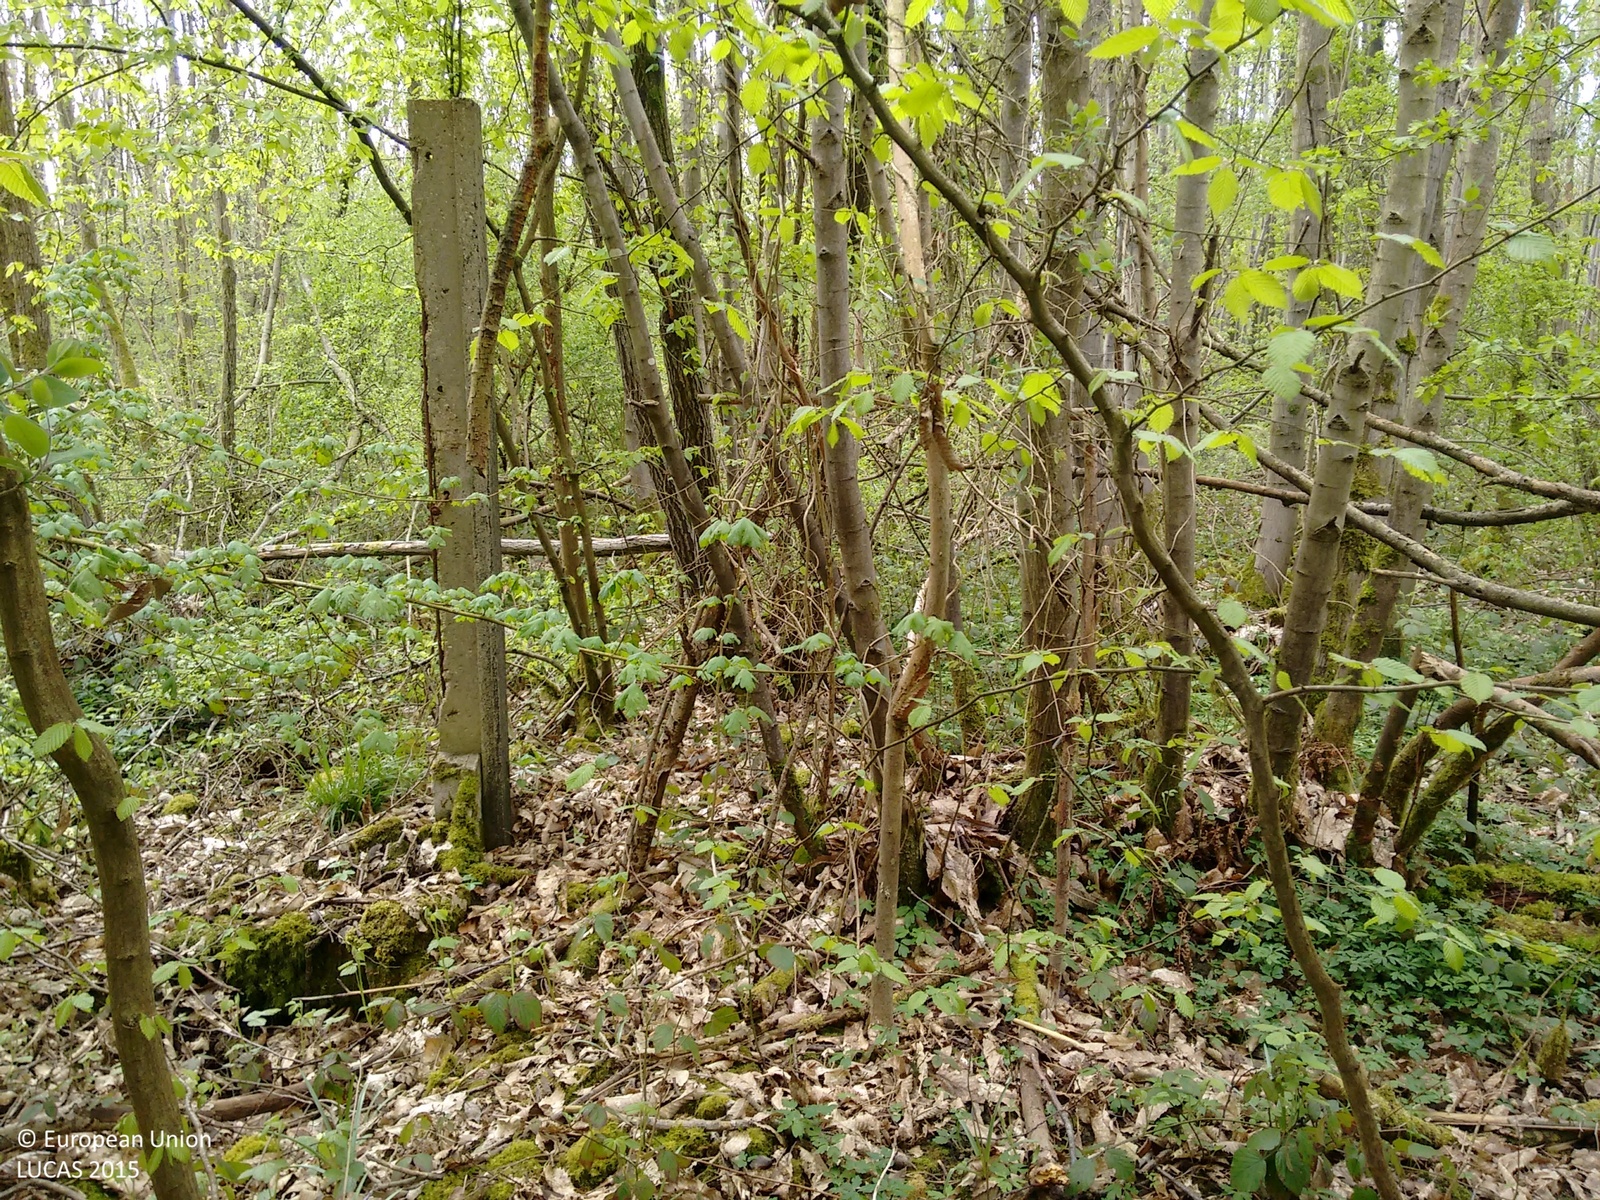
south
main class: Woodland
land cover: Broadleaved woodland
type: mesophytic deciduous forest
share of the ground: > 75 %
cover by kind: broadleaved forest trees 100 %
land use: Forestry
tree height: > 5 m
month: April
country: GB
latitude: 51.3331
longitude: 0.3687
